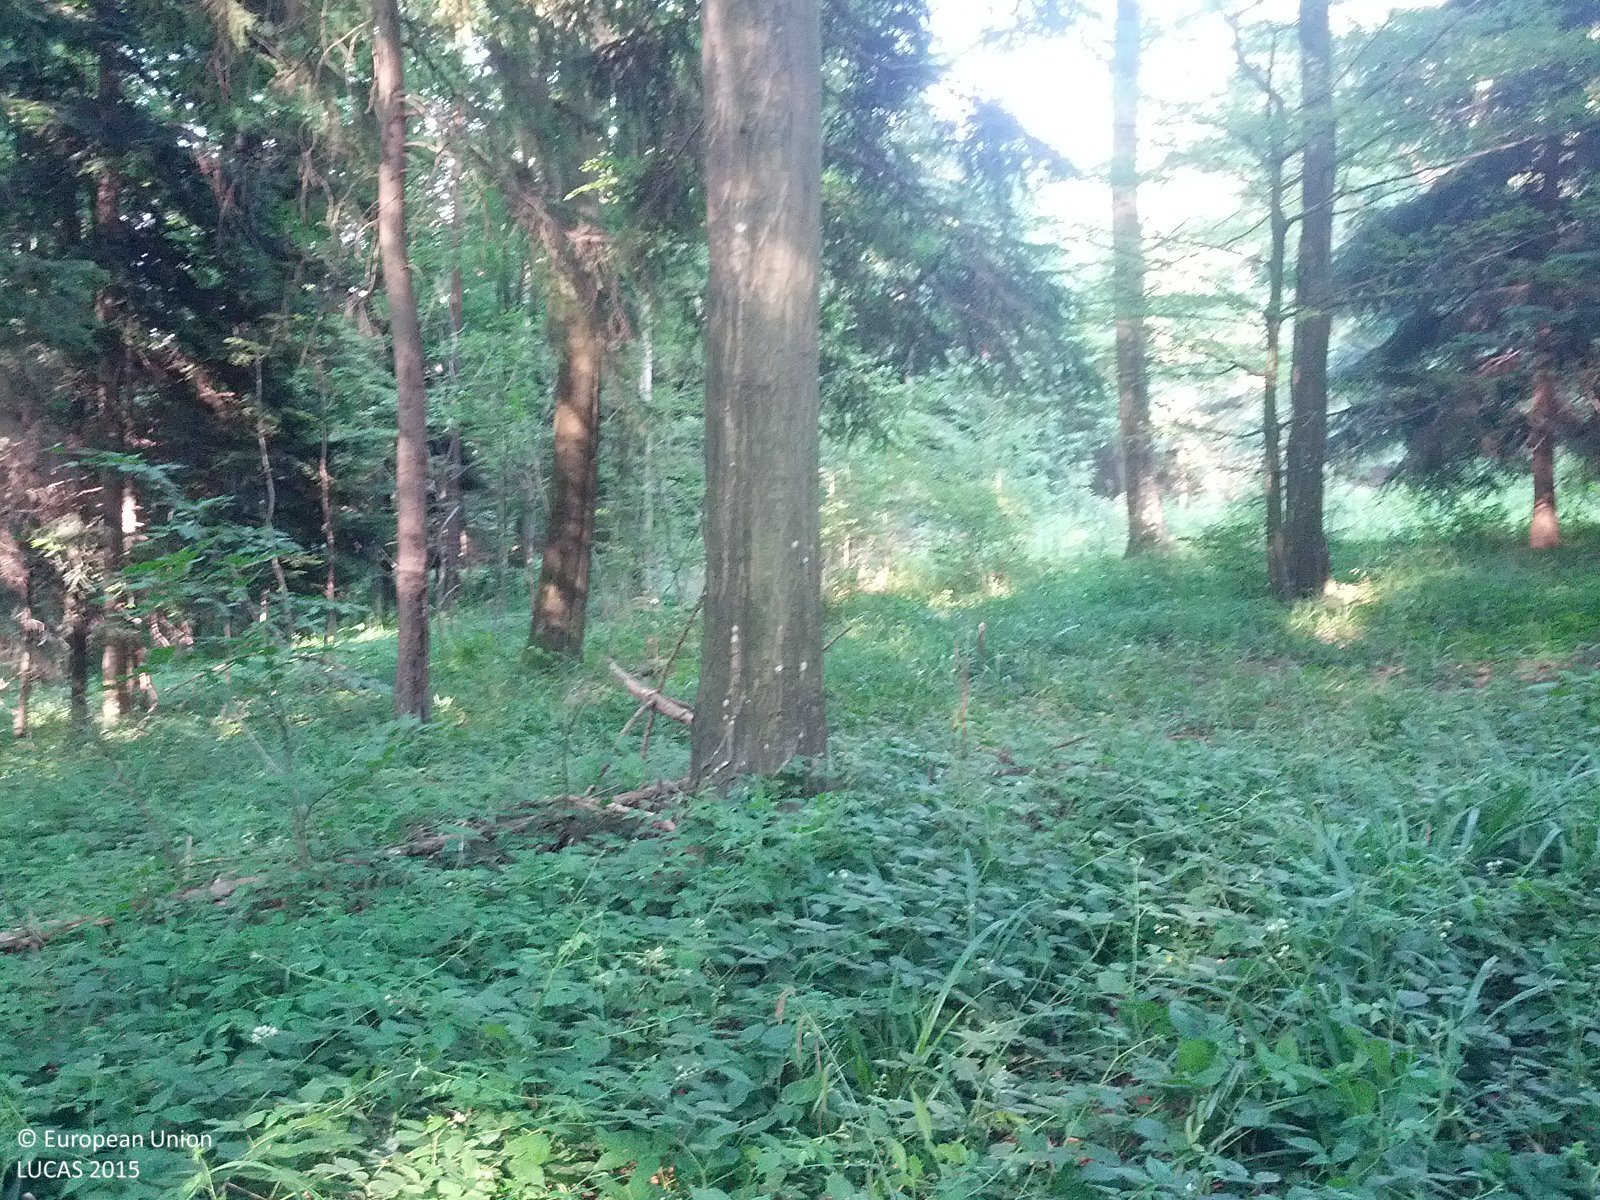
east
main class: Woodland
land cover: Spruce dominated mixed woodland
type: alpine coniferous forest
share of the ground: > 75 %
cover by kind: coniferous forest trees 60 %, broadleaved forest trees 30 %, herbaceous plants 5 %, lichens and mosses 5 %
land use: Forestry
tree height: > 5 m
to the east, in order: Spruce dominated mixed woodland; Spruce dominated coniferous woodland; Tracks; Spruce dominated coniferous woodland
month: June
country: AT
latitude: 48.1647
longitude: 16.0677
